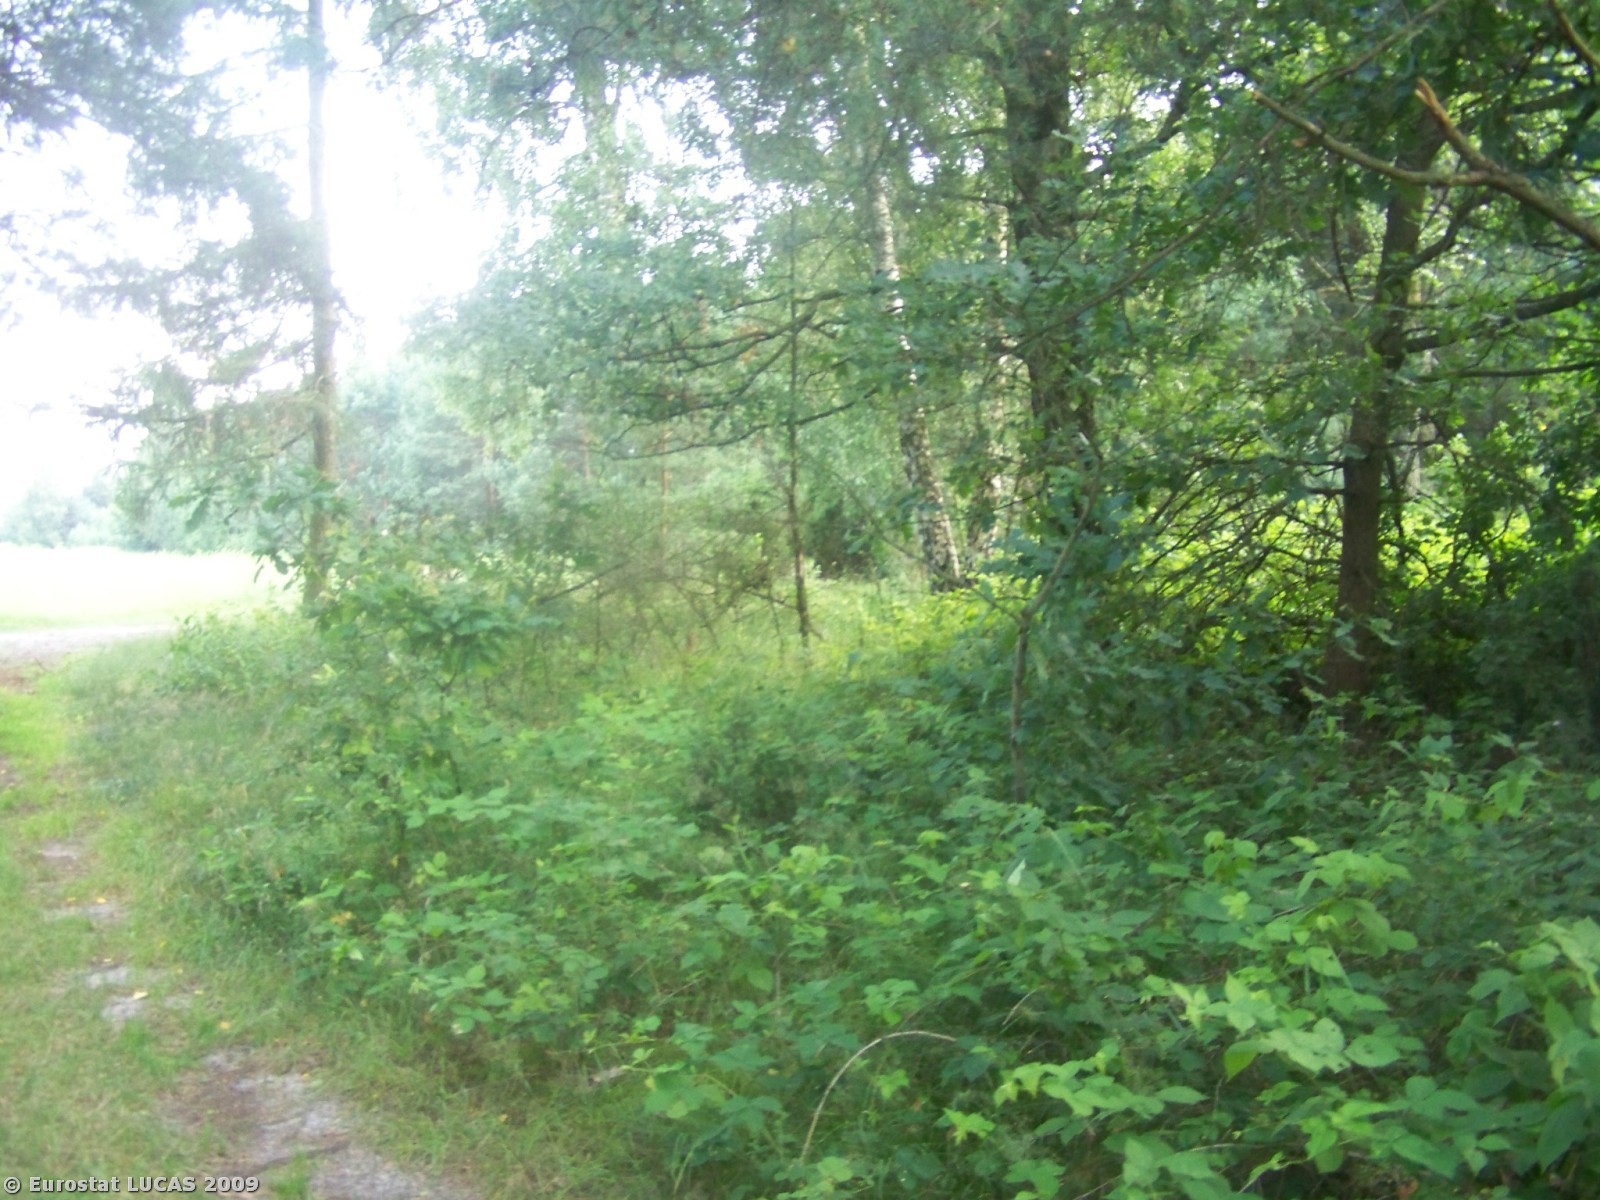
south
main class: Woodland
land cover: Coniferous woodland
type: hemiboreal forest and nemoral coniferous forest and mixed broadleaved-coniferous forest
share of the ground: > 75 %
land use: Forestry
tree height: > 5 m
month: July
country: PL
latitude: 52.0236
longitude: 21.6095
